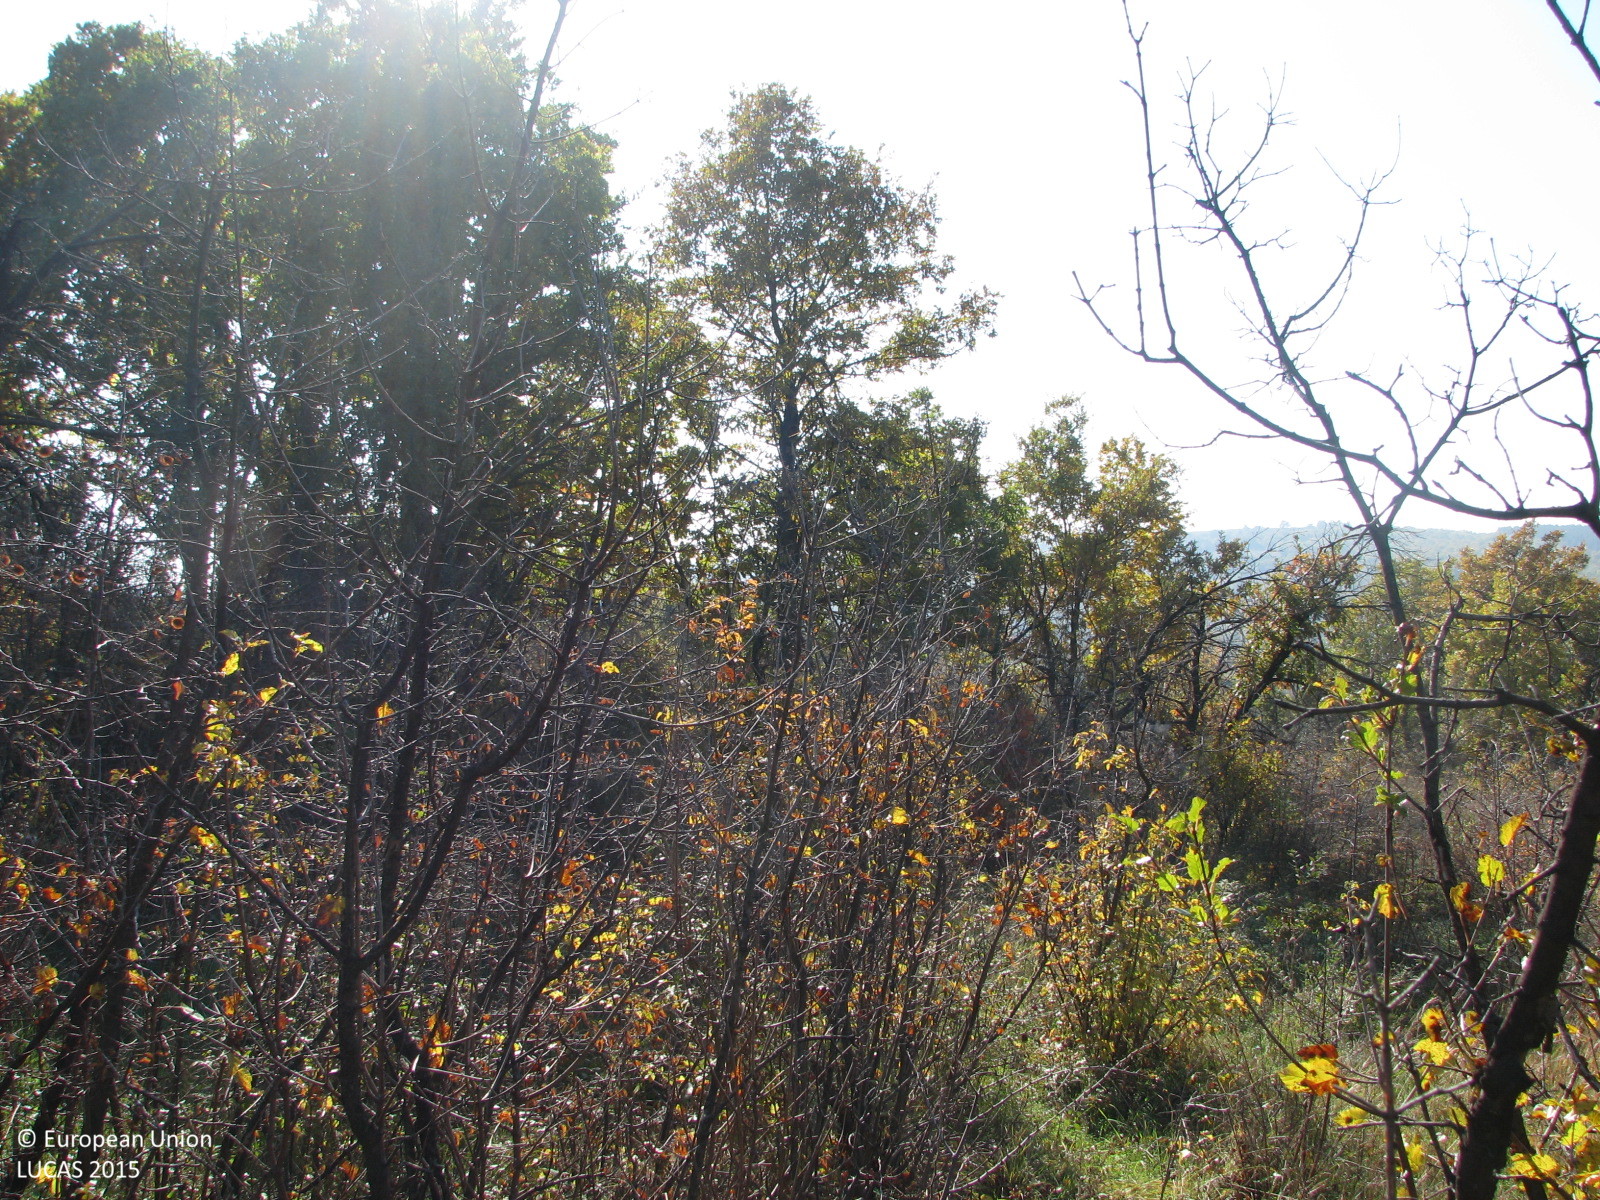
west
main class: Shrubland
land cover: Shrubland with sparse tree cover
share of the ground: 50 - 75 %
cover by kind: shrubs 50 %, herbaceous plants 45 %, broadleaved forest trees 5 %
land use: Semi-natural and natural areas not in use
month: November
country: BG
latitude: 42.0643
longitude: 26.7084
